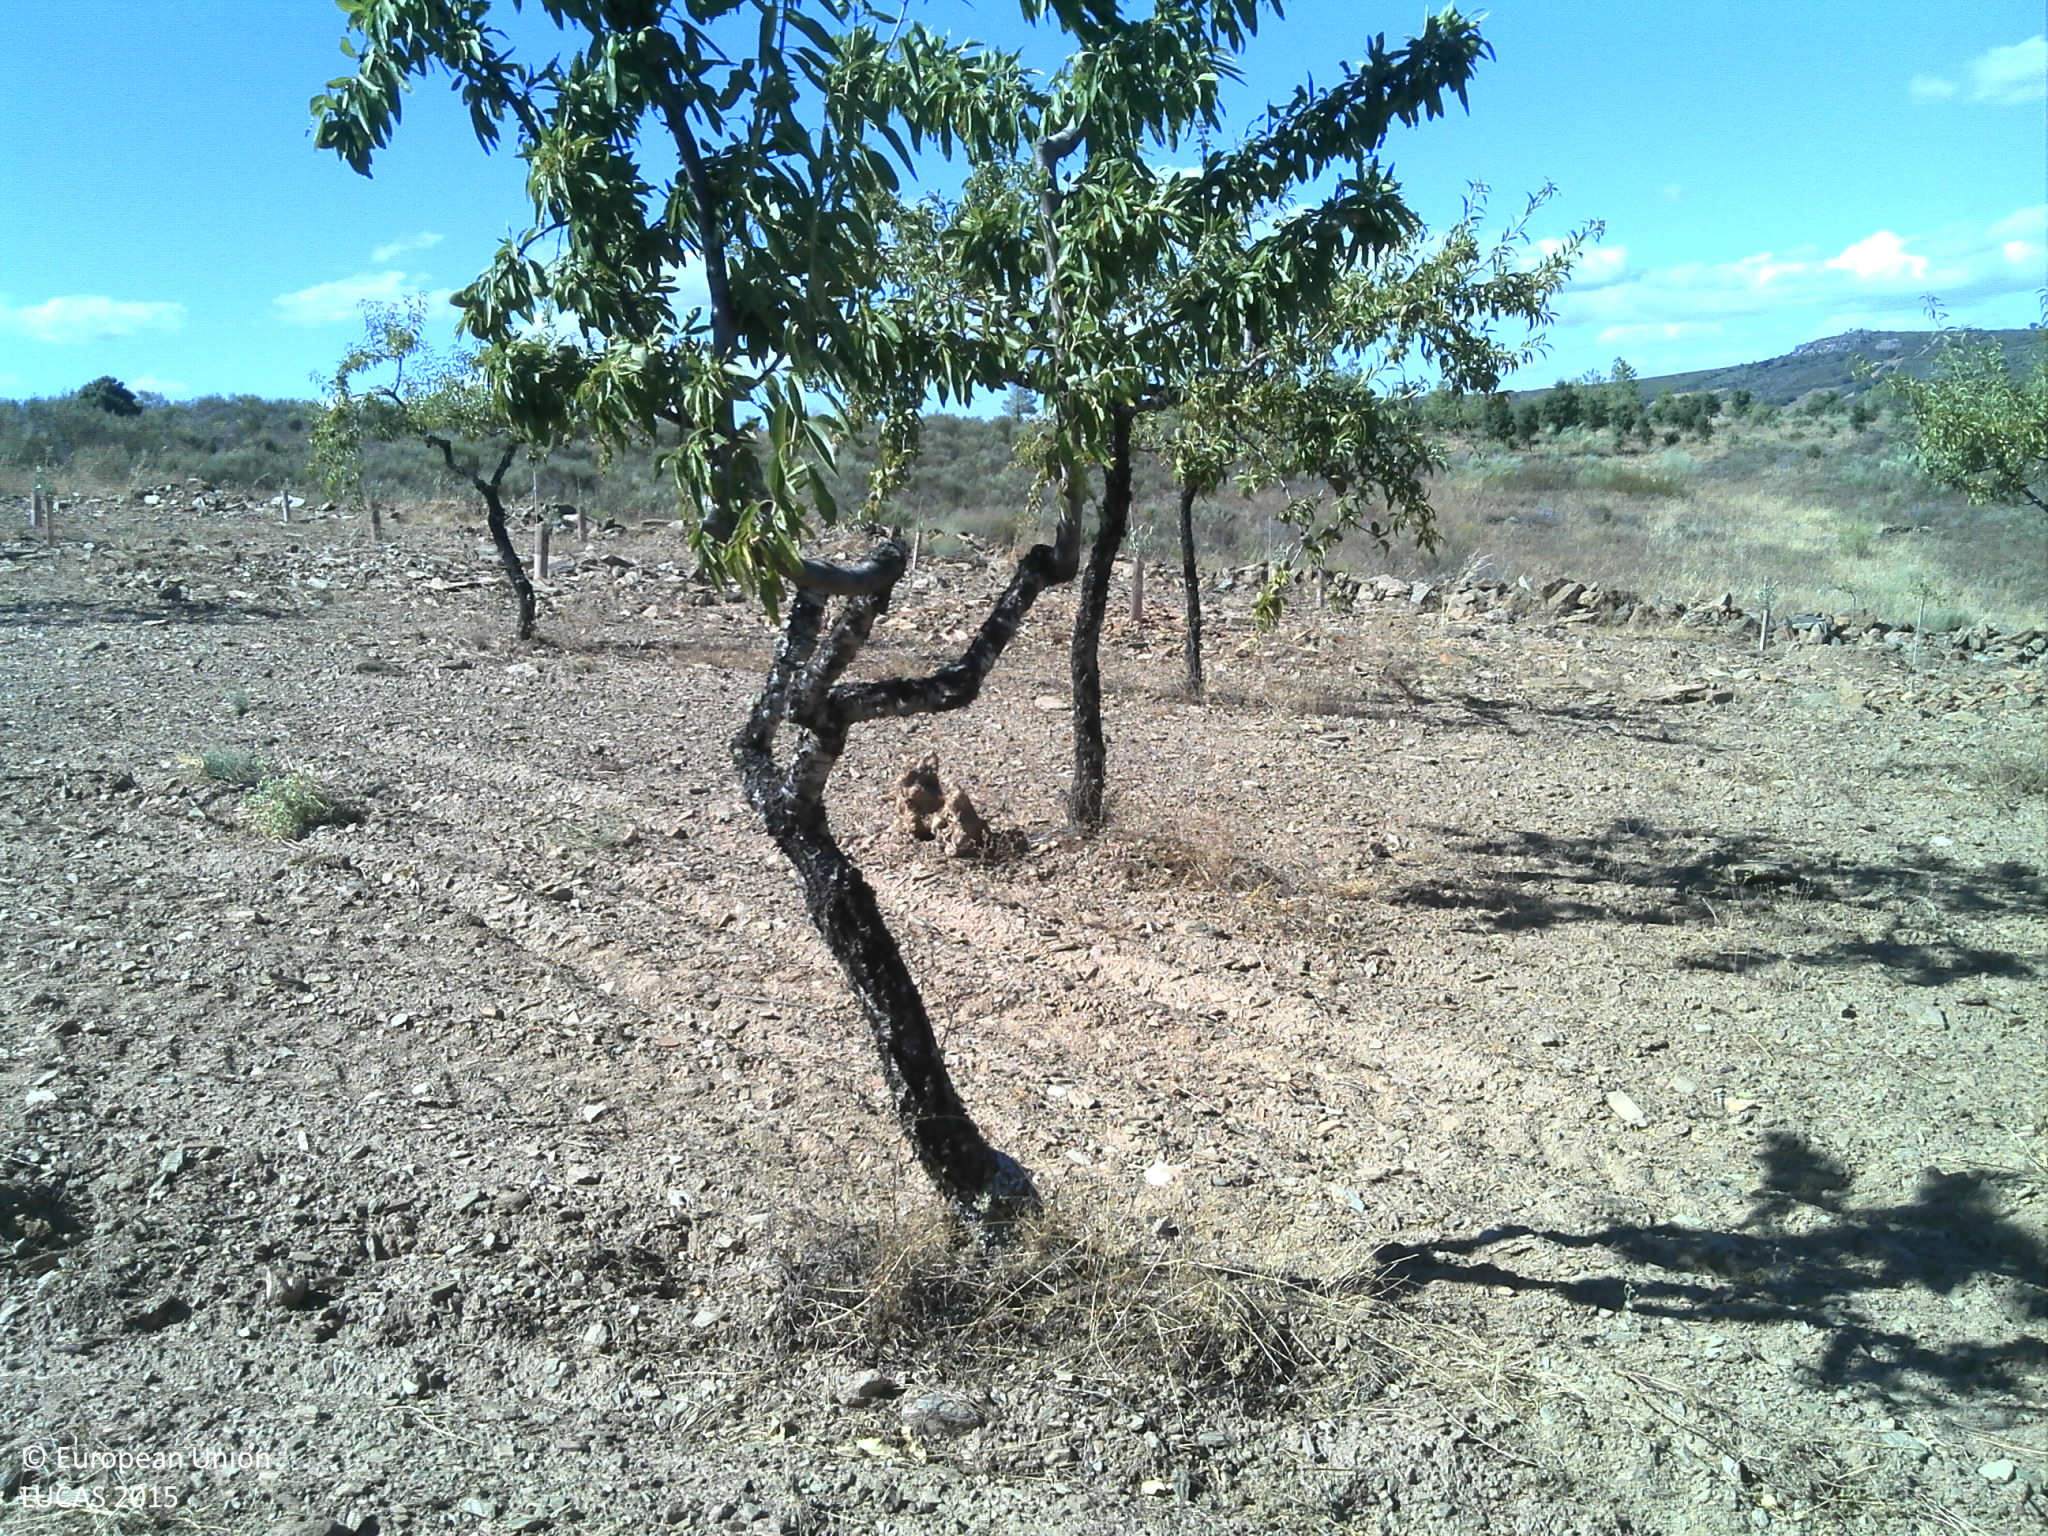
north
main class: Cropland
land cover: Nuts trees
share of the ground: < 10 %
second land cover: Other bare soil
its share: > 75 %
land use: Agriculture (excluding fallow land and kitchen gardens)
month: July
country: PT
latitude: 41.2774
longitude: -7.0045
